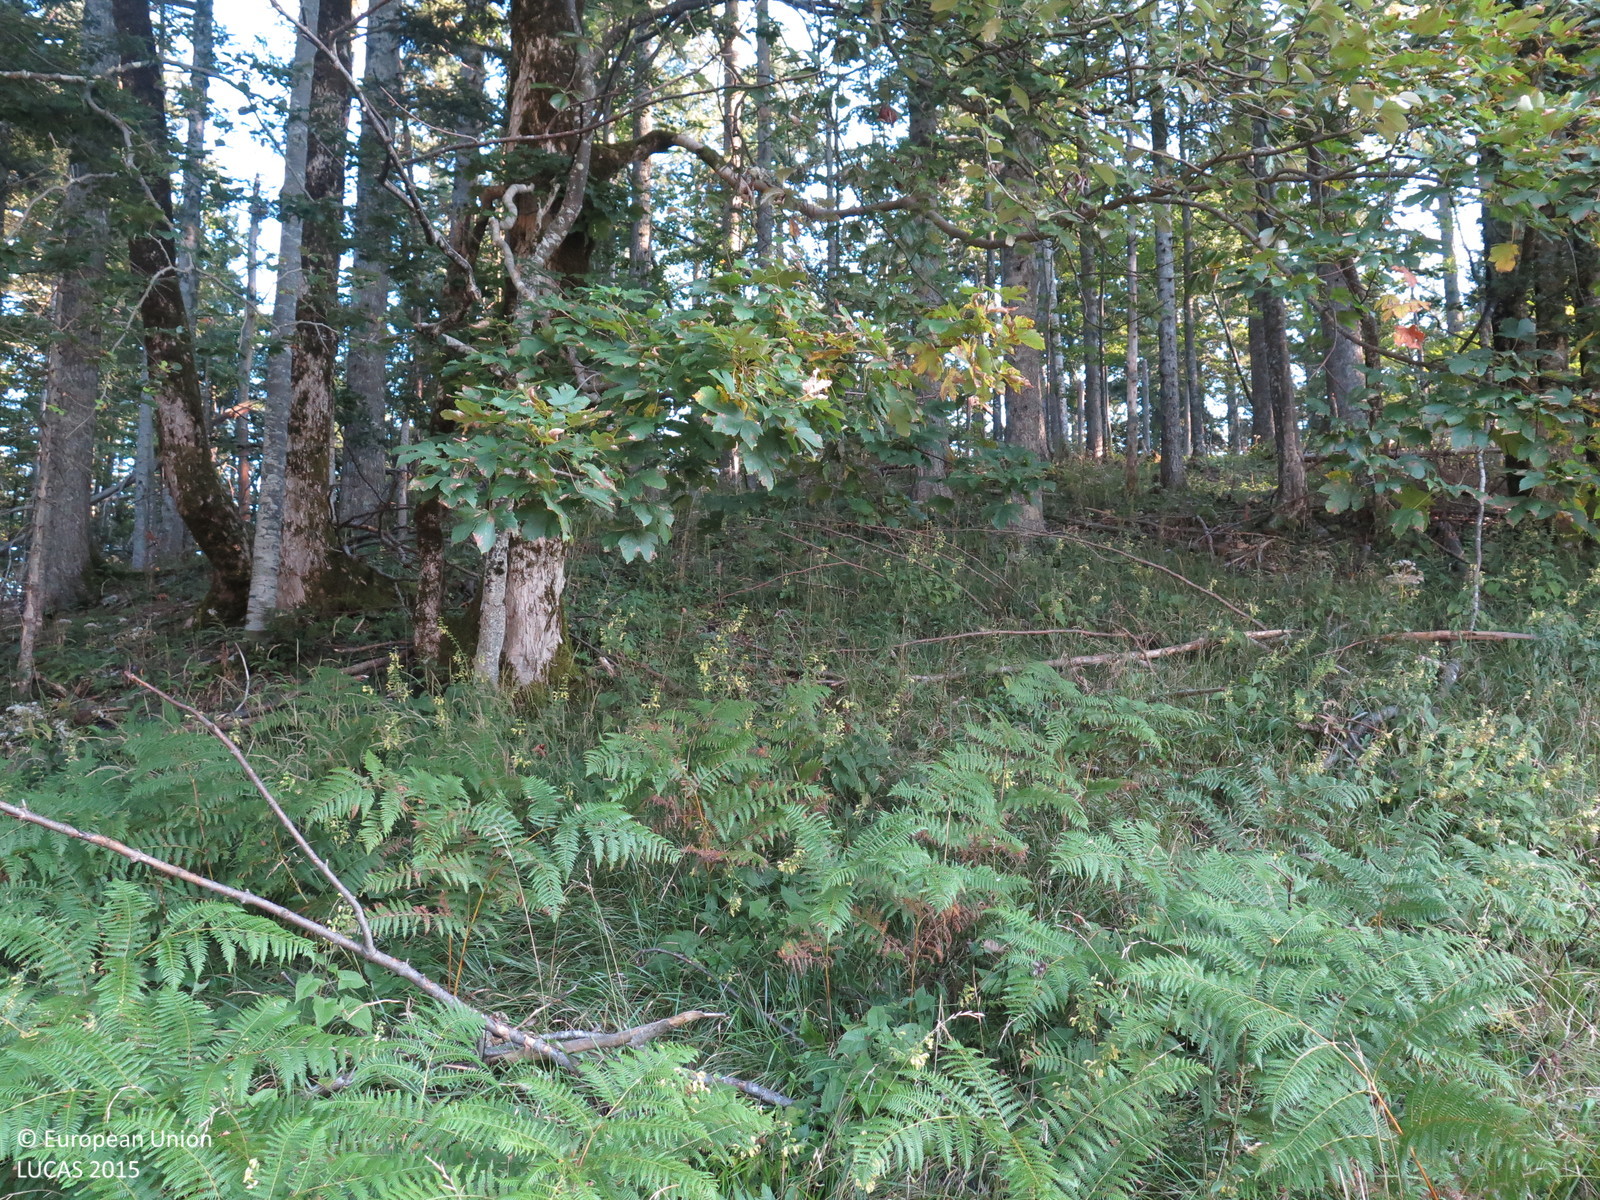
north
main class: Woodland
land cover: Other mixed woodland
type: mountainous beech forest
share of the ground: > 75 %
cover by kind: coniferous forest trees 75 %, broadleaved forest trees 25 %
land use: Forestry
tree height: > 5 m
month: September
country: HR
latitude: 45.5118
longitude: 14.6163
